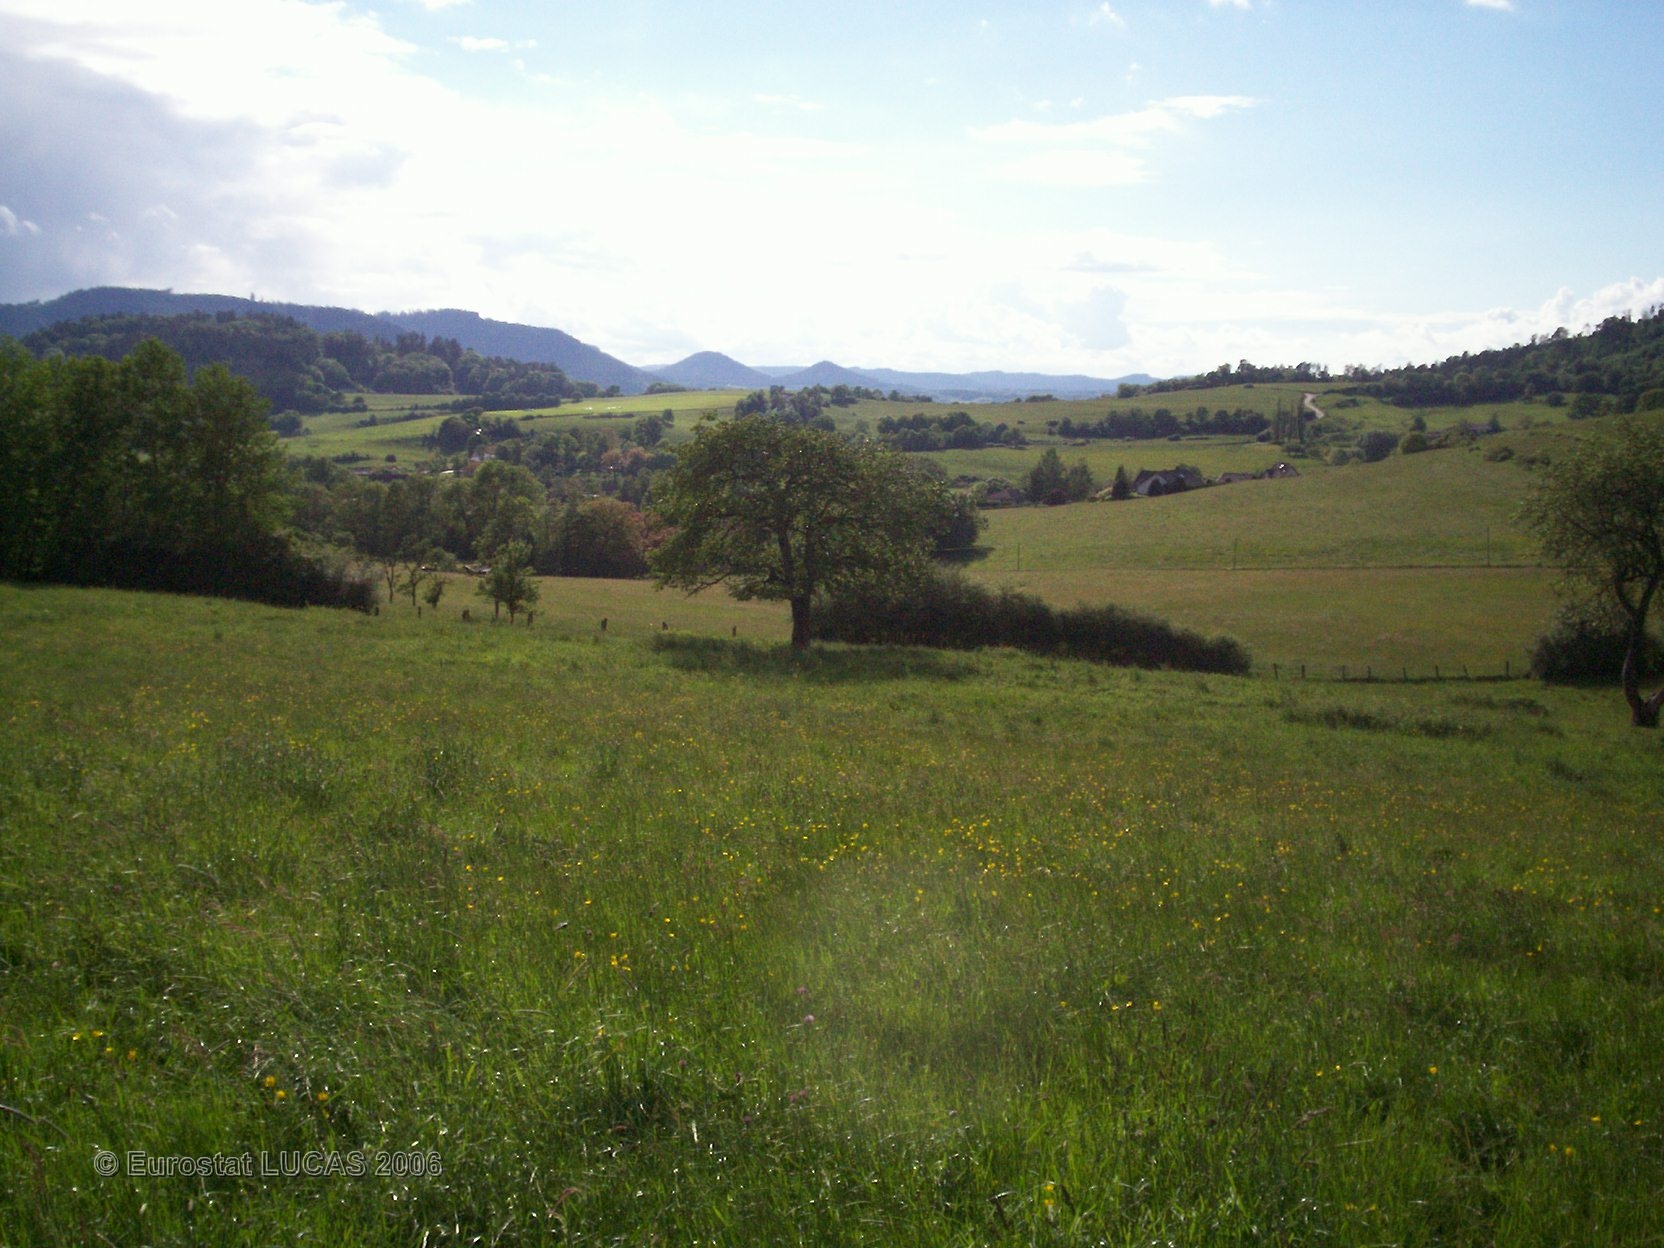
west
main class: Grassland
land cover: Grassland without tree/shrub cover
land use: Agriculture (excluding fallow land and kitchen gardens)
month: May
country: FR
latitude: 48.3079
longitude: 6.9672
